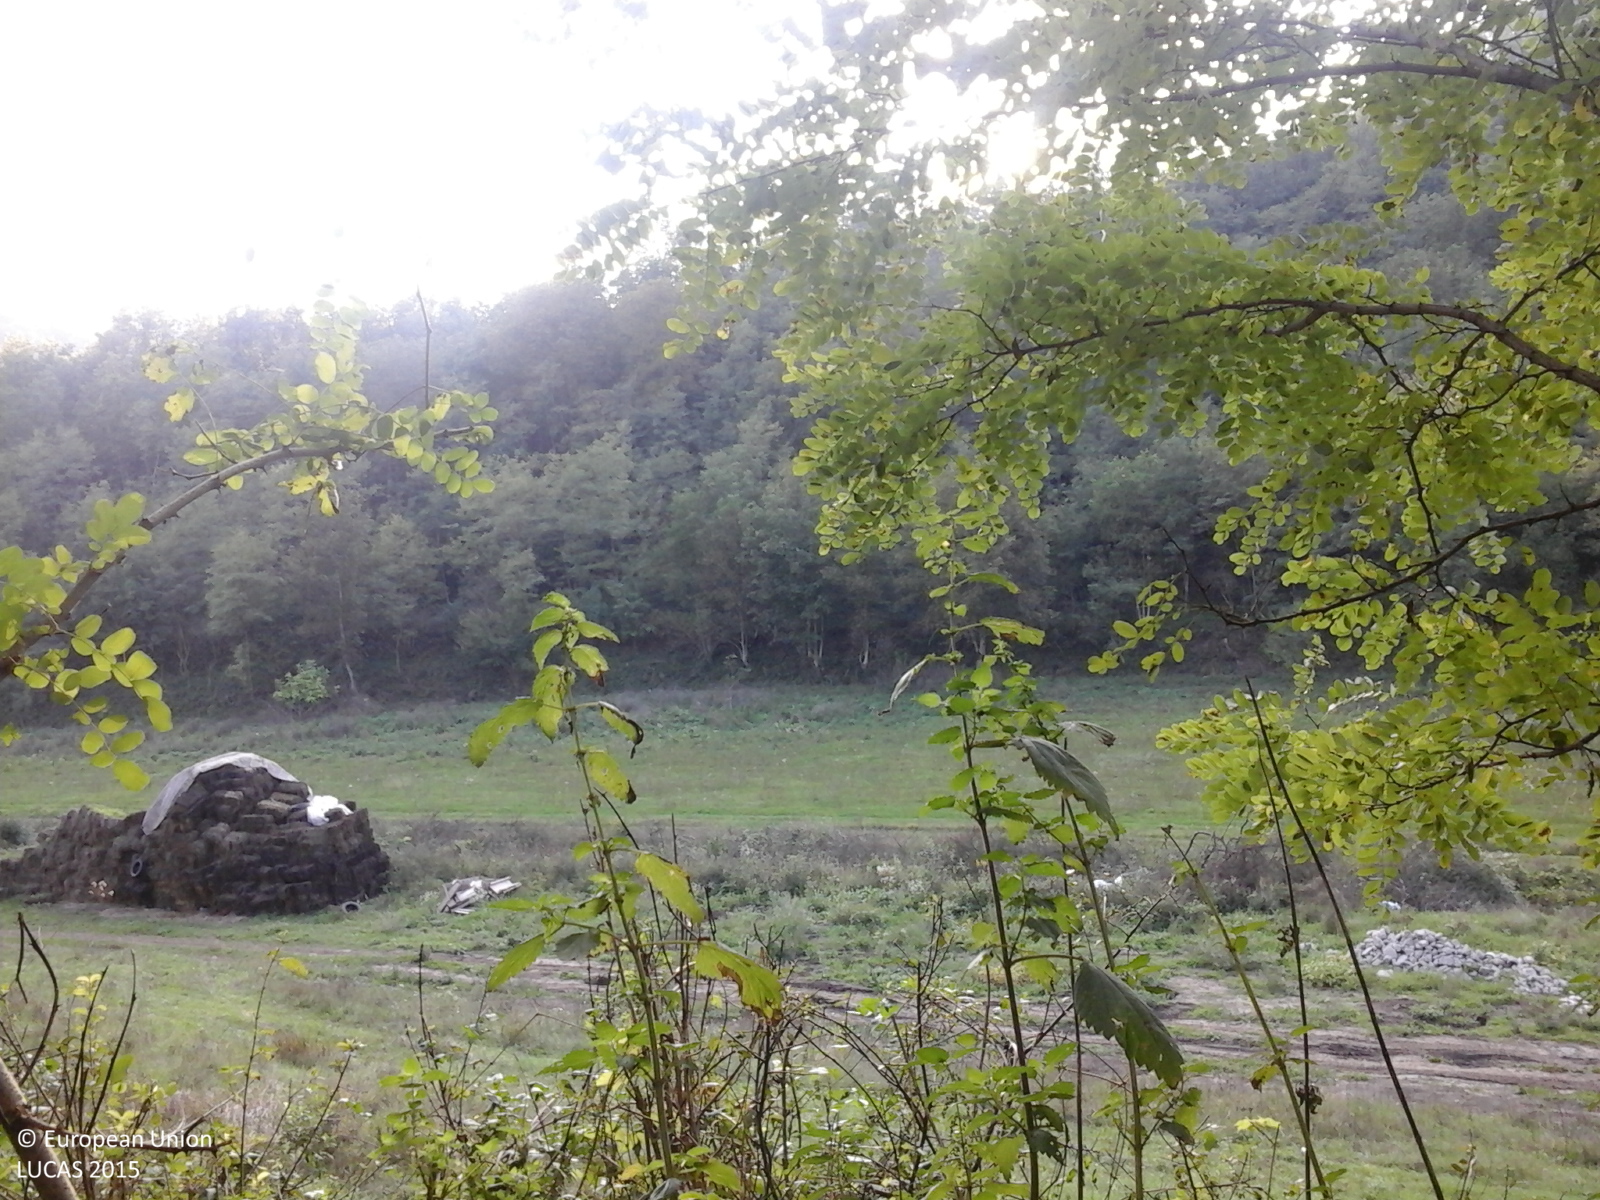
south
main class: Woodland
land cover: Broadleaved woodland
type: exotic forest
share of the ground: > 75 %
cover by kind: broadleaved forest trees 100 %
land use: Forestry
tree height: > 5 m
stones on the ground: < 10 %
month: October
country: RO
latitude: 46.0763
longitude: 24.1844
